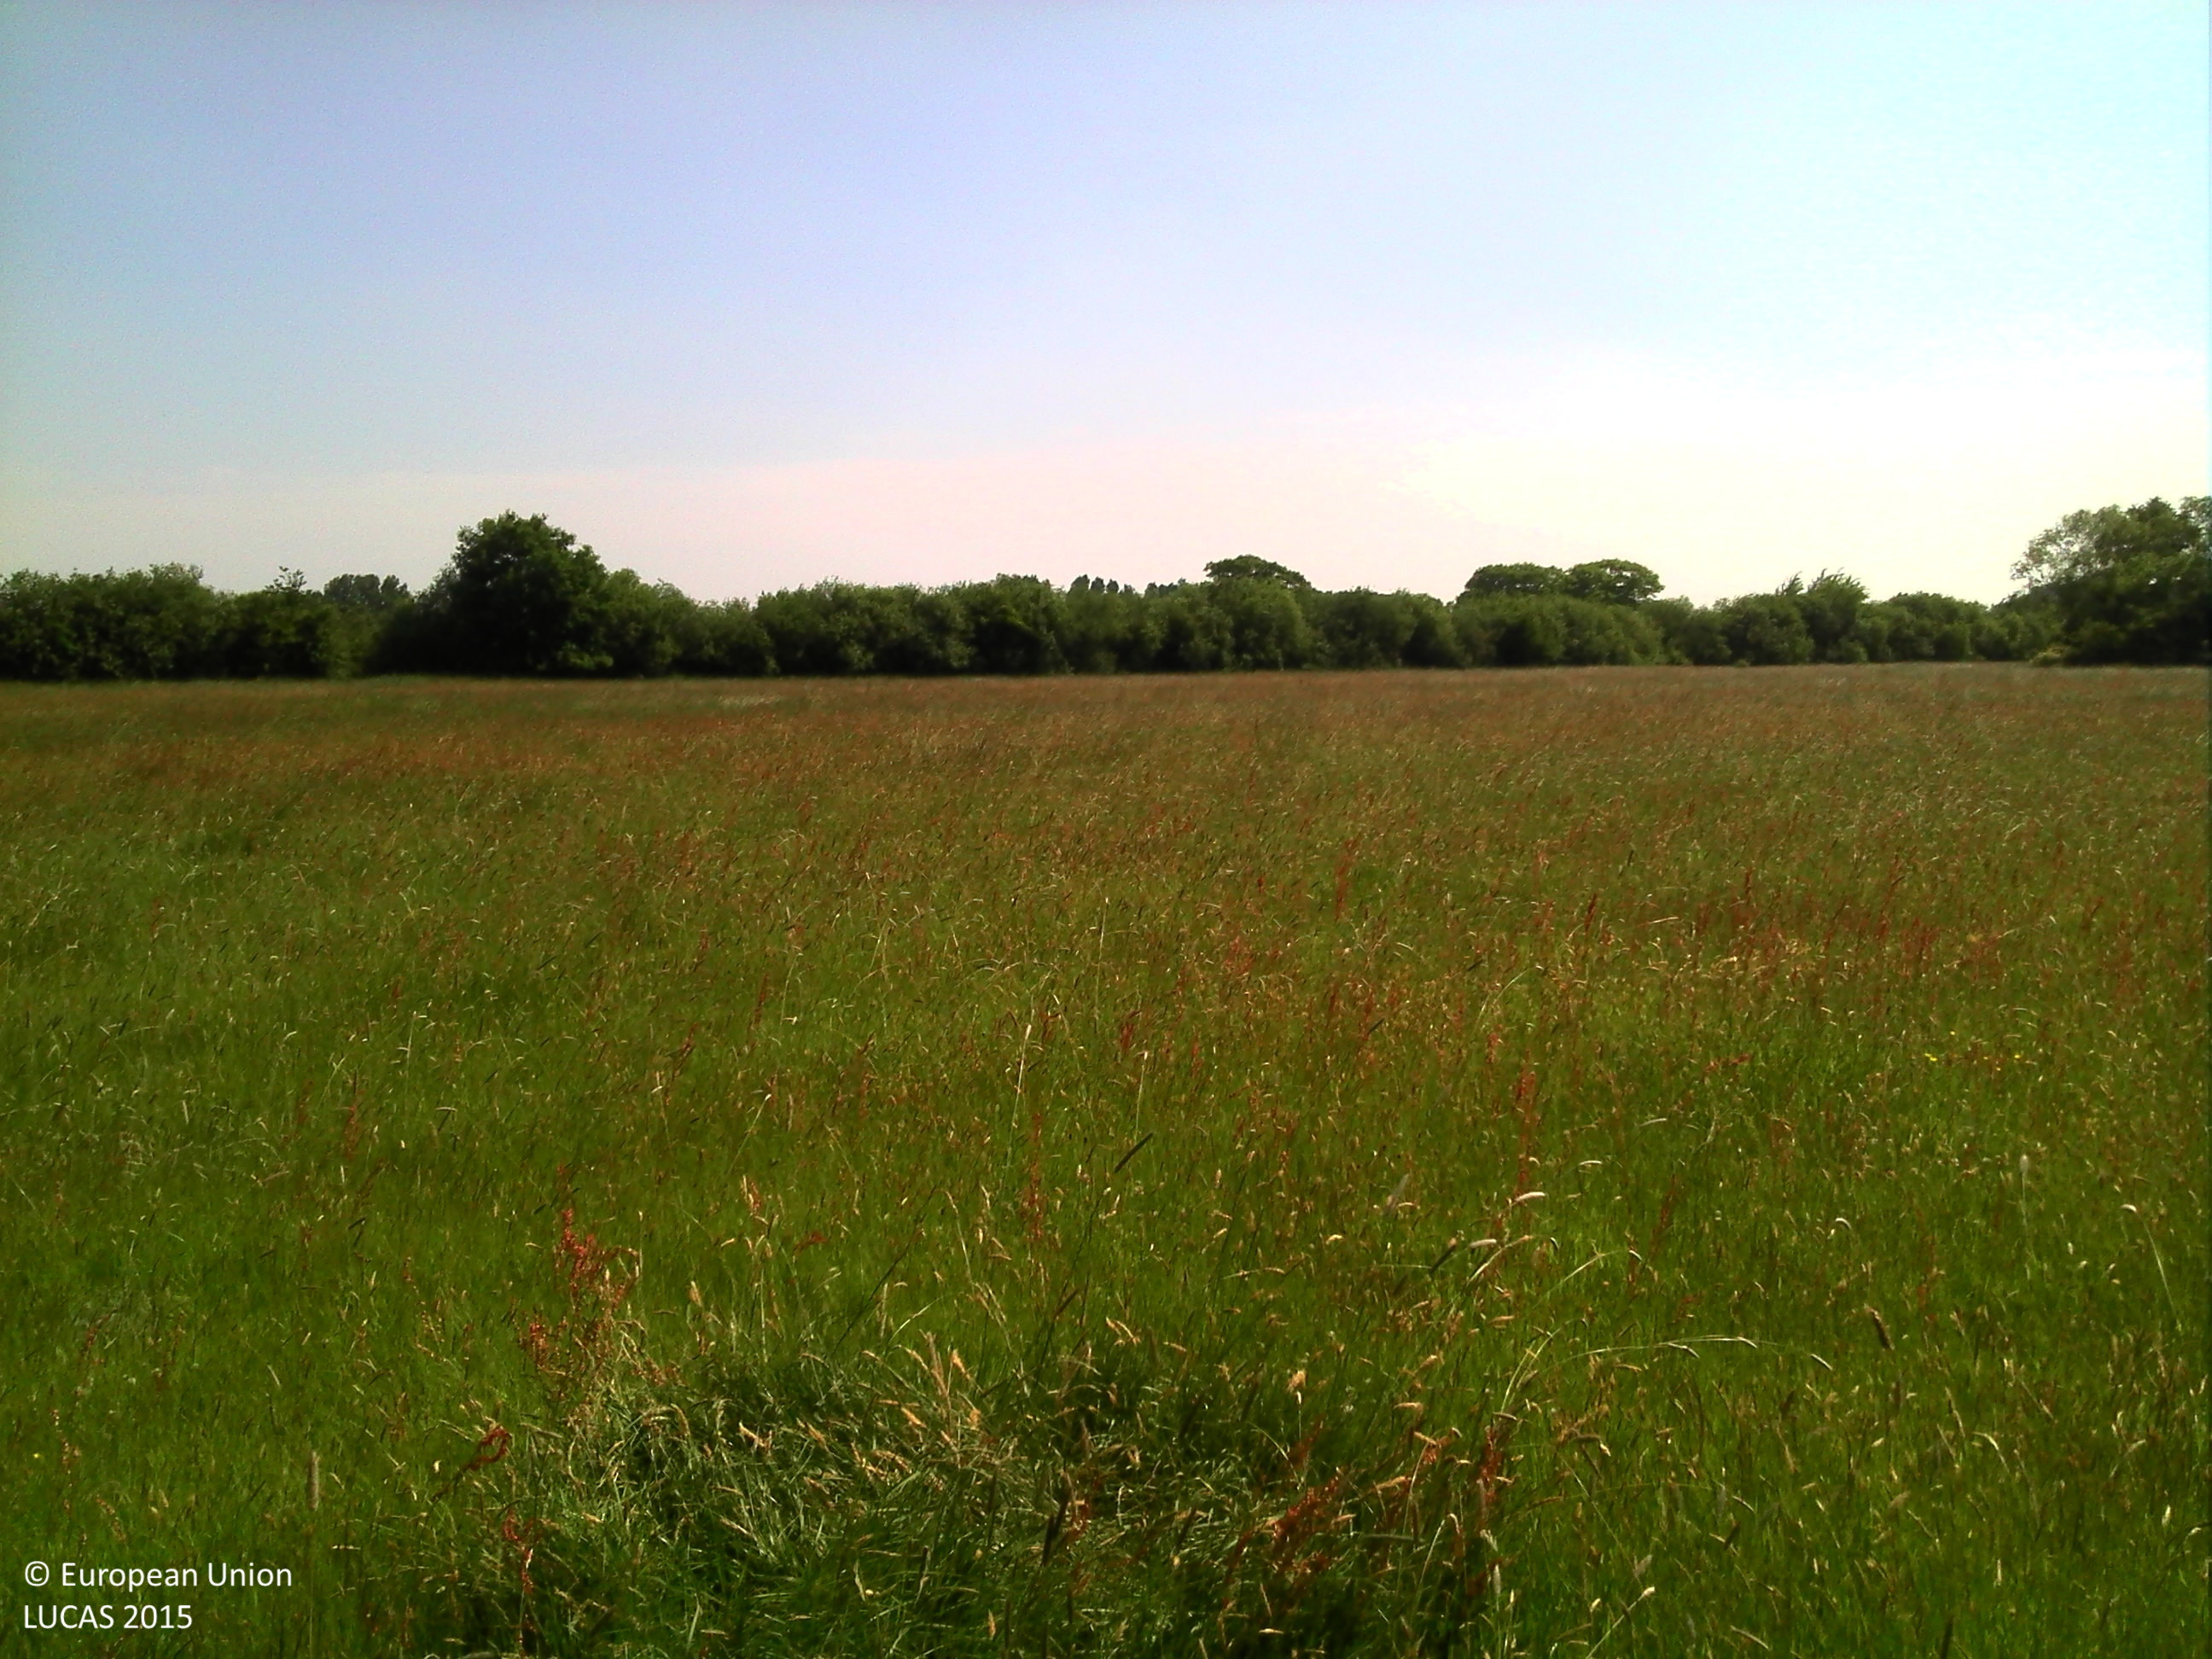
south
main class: Grassland
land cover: Grassland without tree/shrub cover
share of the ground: > 75 %
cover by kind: herbaceous plants 100 %
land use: Agriculture (excluding fallow land and kitchen gardens)
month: June
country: BE
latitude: 50.9646
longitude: 5.1705
